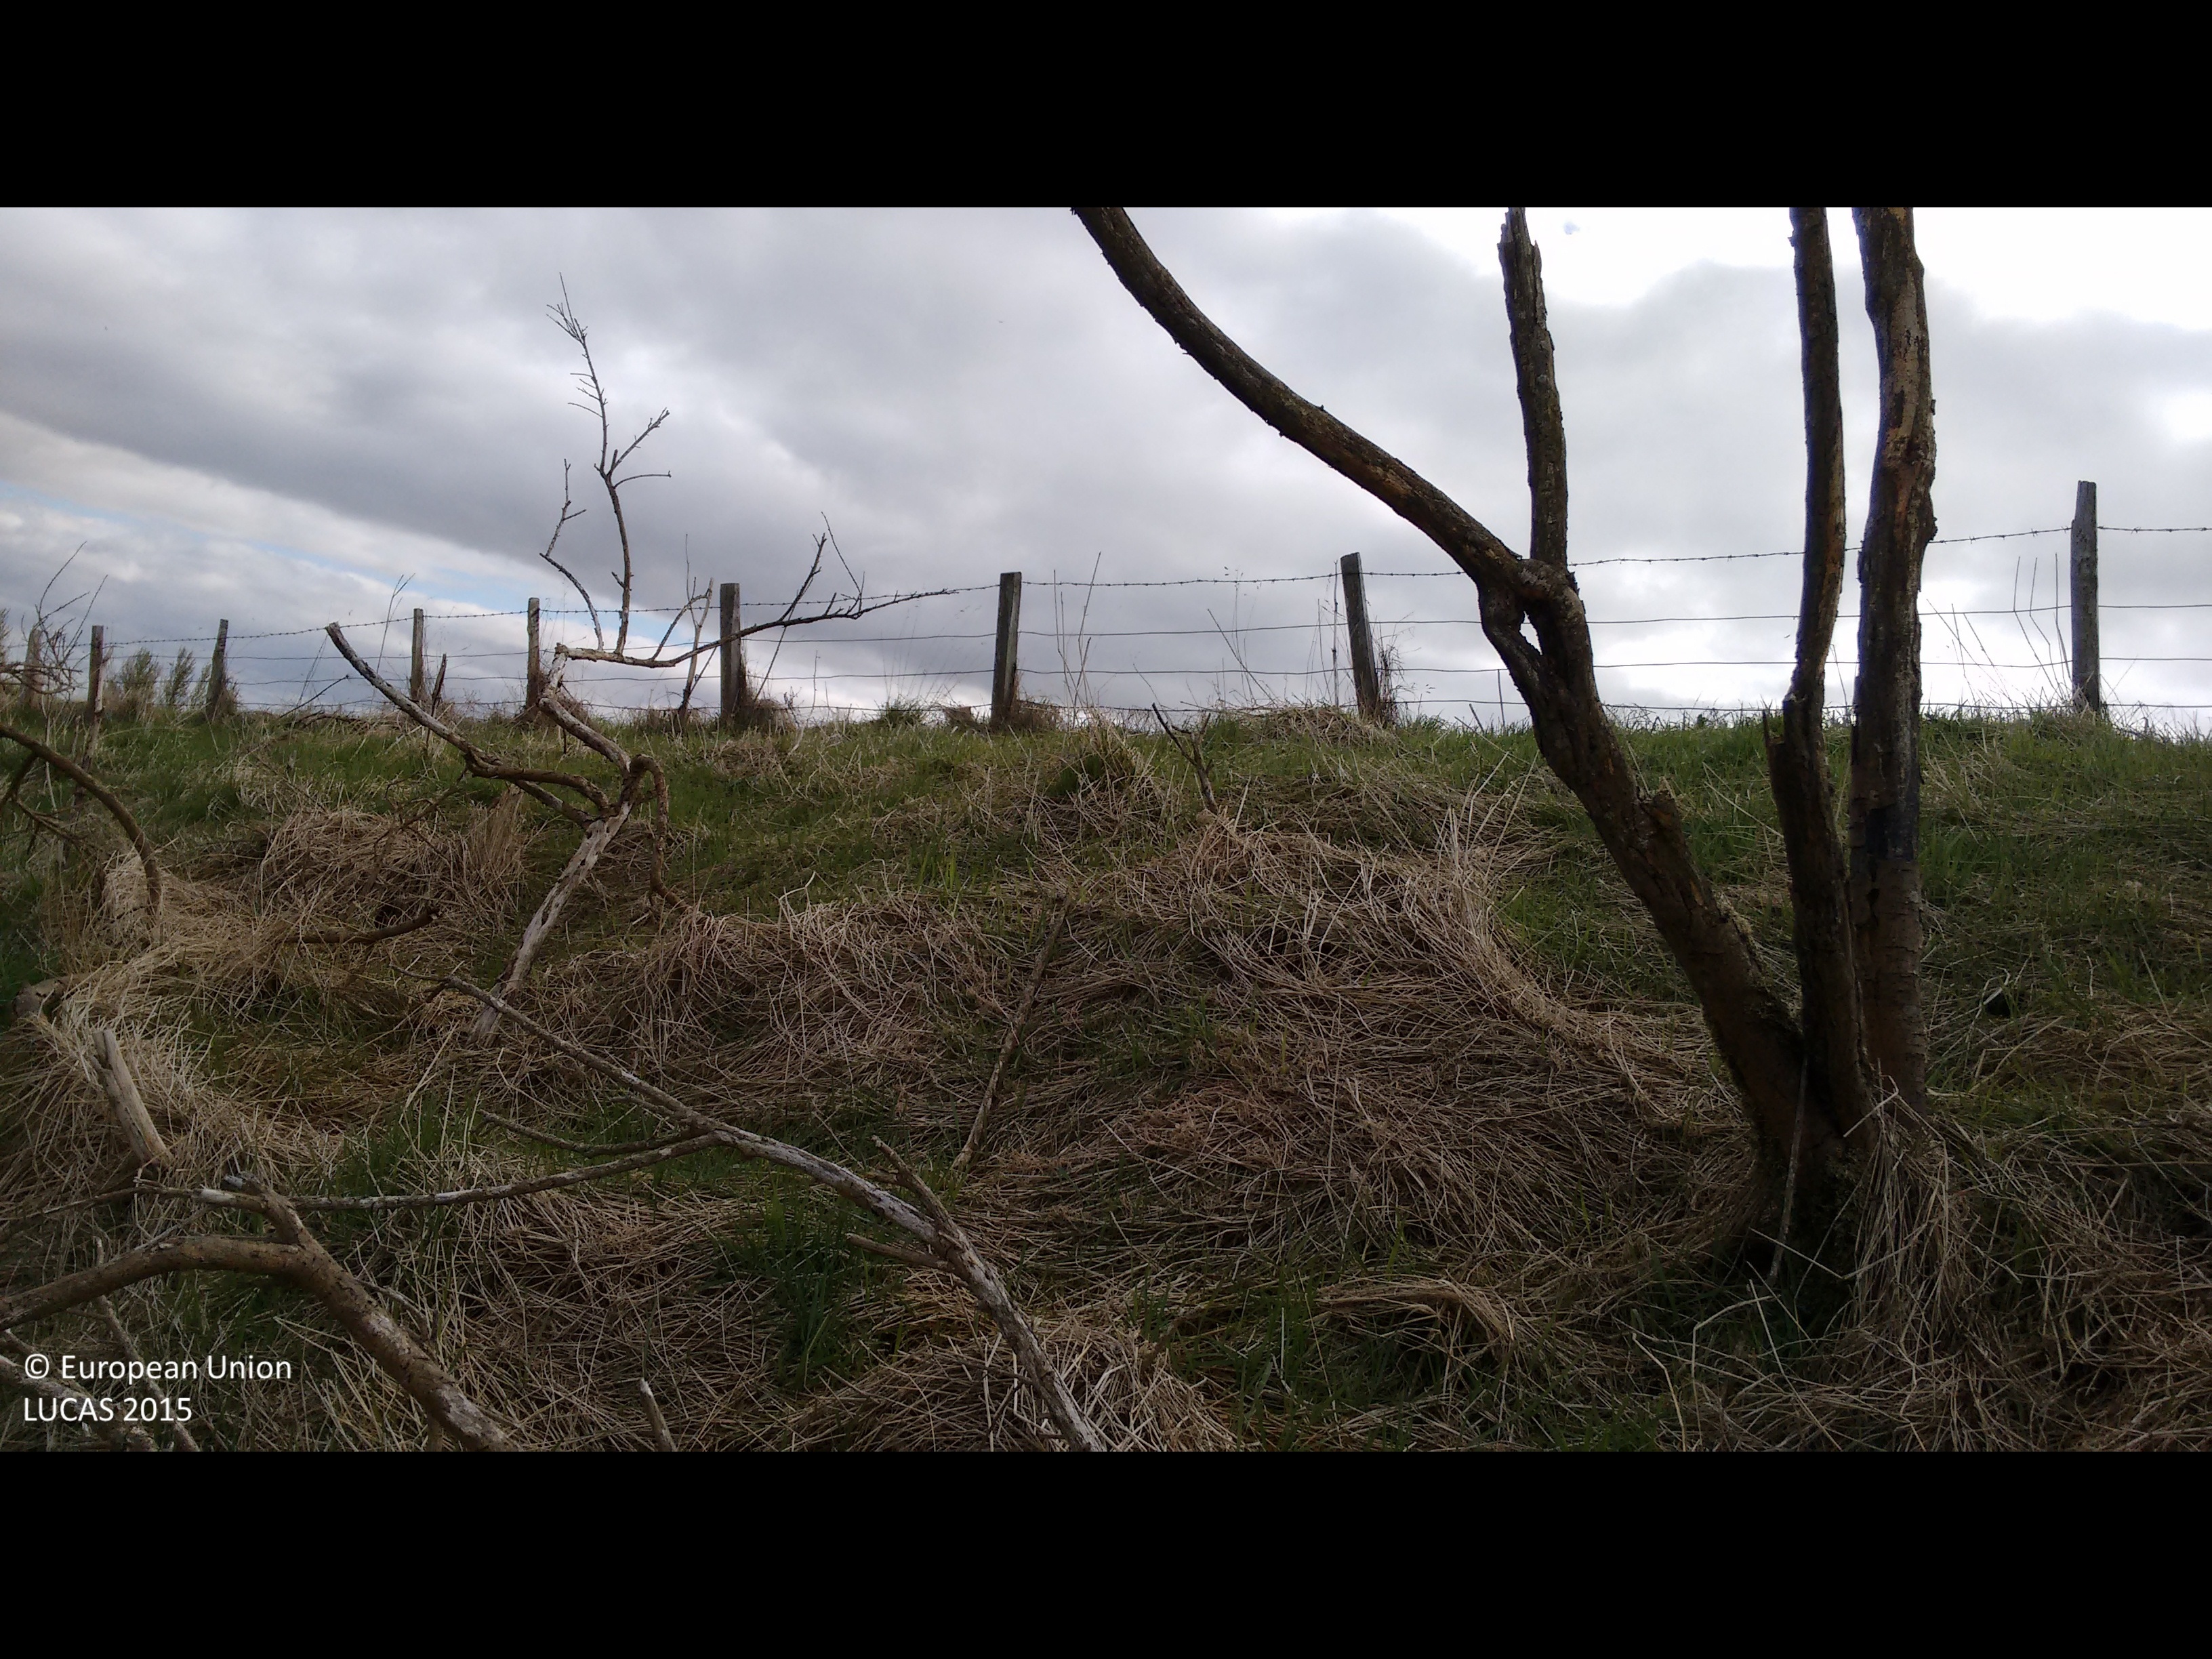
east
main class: Shrubland
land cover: Shrubland without tree cover
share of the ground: 50 - 75 %
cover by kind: herbaceous plants 60 %, shrubs 40 %
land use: Semi-natural and natural areas not in use
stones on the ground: 10 - 25 %
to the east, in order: Shrubland without tree cover; Spontaneously vegetated surfaces; Fences; Grass margins; Other bare soil
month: May
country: GB
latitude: 56.5800
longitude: -3.0079
